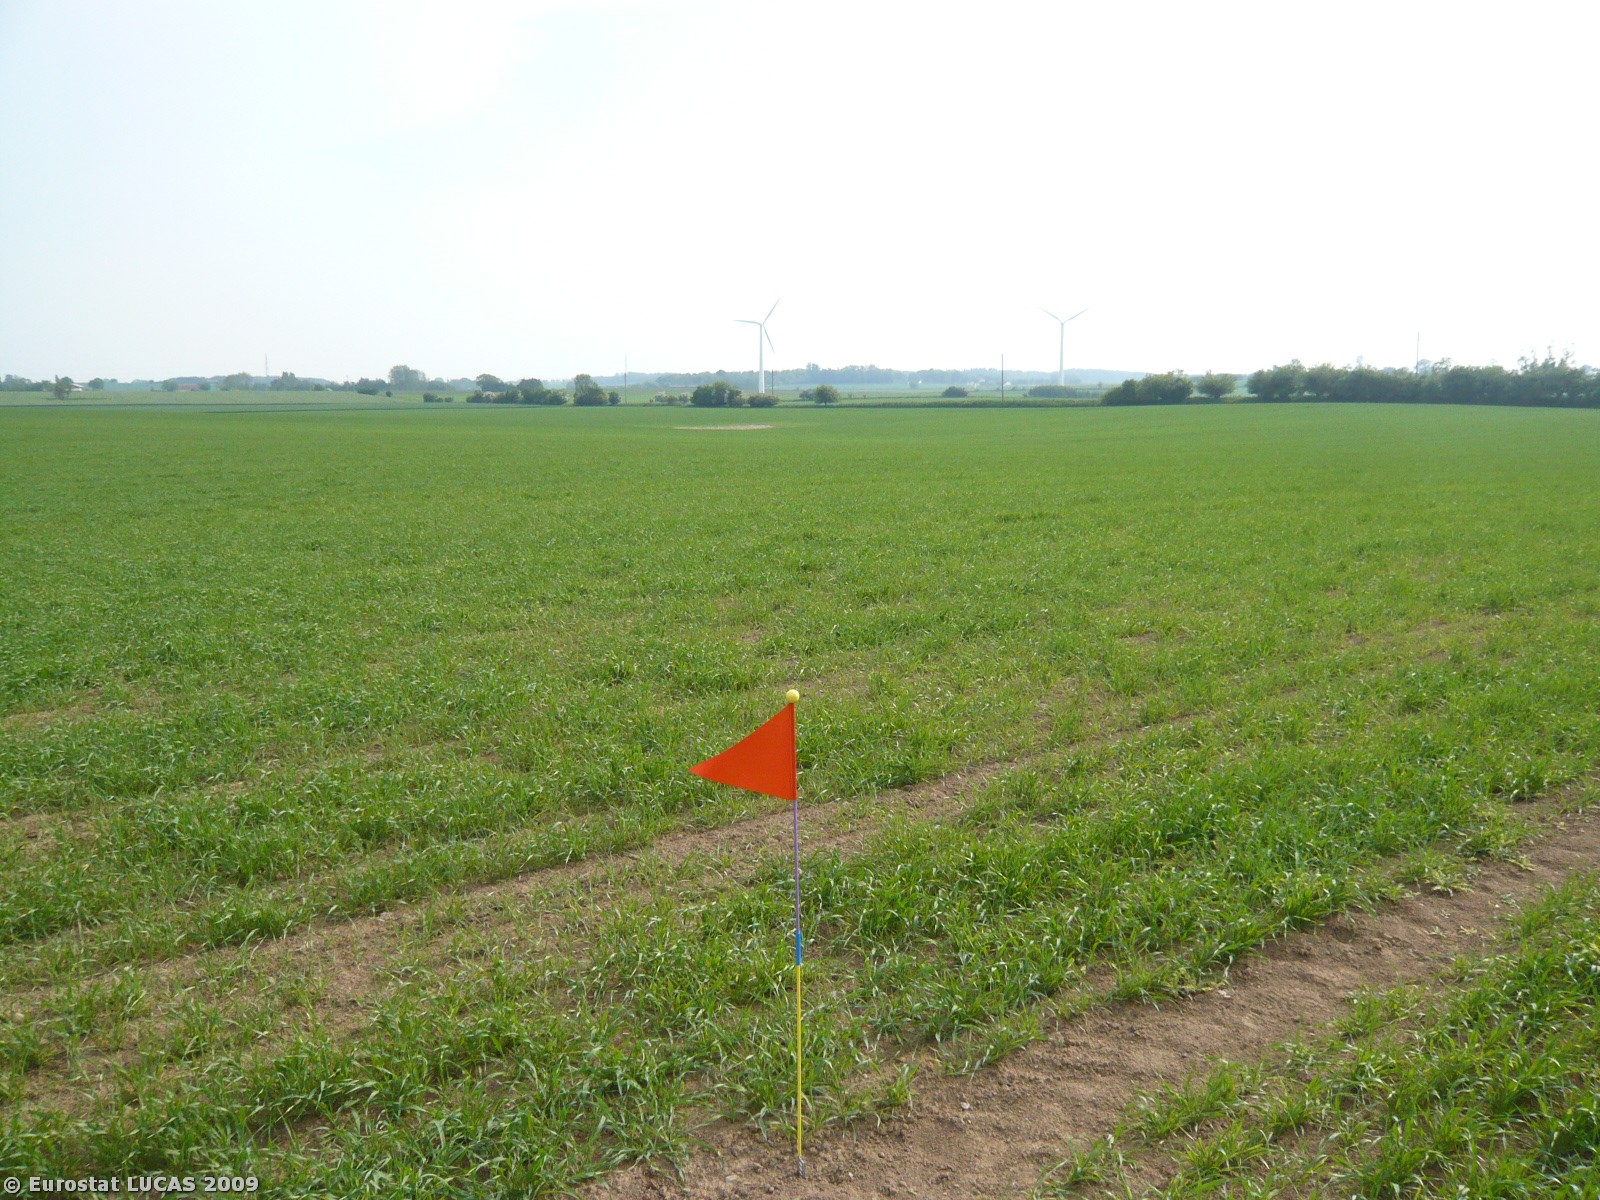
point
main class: Cropland
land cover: Barley
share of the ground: 50 - 75 %
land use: Agriculture (excluding fallow land and kitchen gardens)
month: May
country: DK
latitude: 55.2423
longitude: 11.6501
